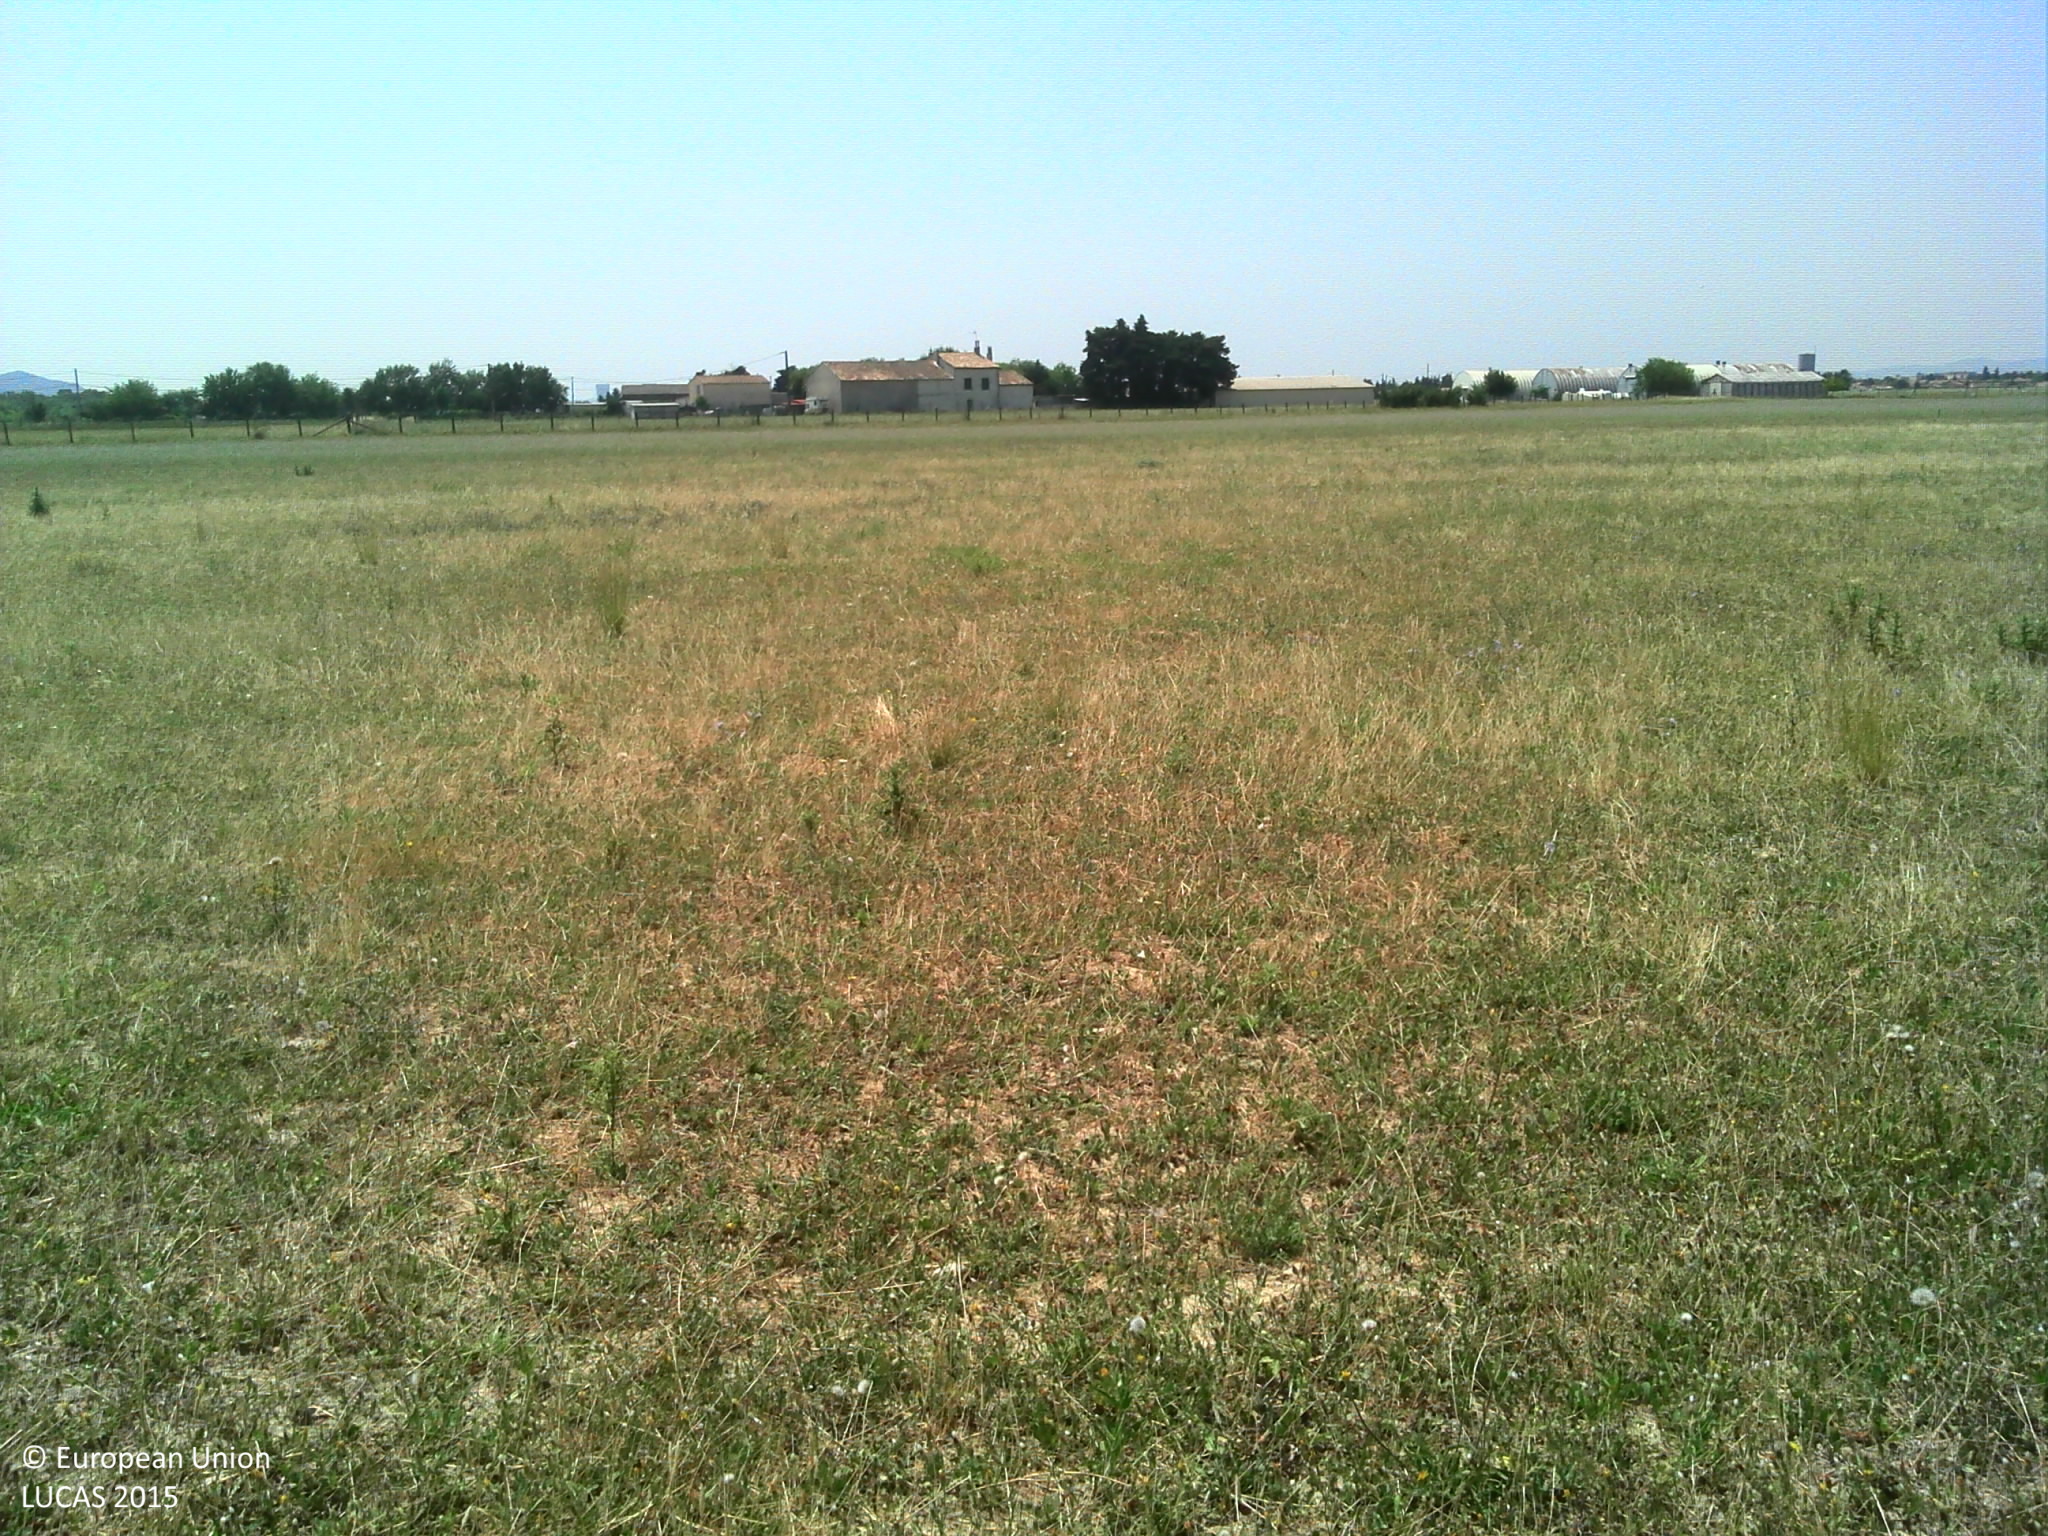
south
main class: Grassland
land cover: Grassland without tree/shrub cover
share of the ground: > 75 %
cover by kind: herbaceous plants 100 %
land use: Agriculture (excluding fallow land and kitchen gardens)
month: July
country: FR
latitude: 44.3969
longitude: 4.7216
